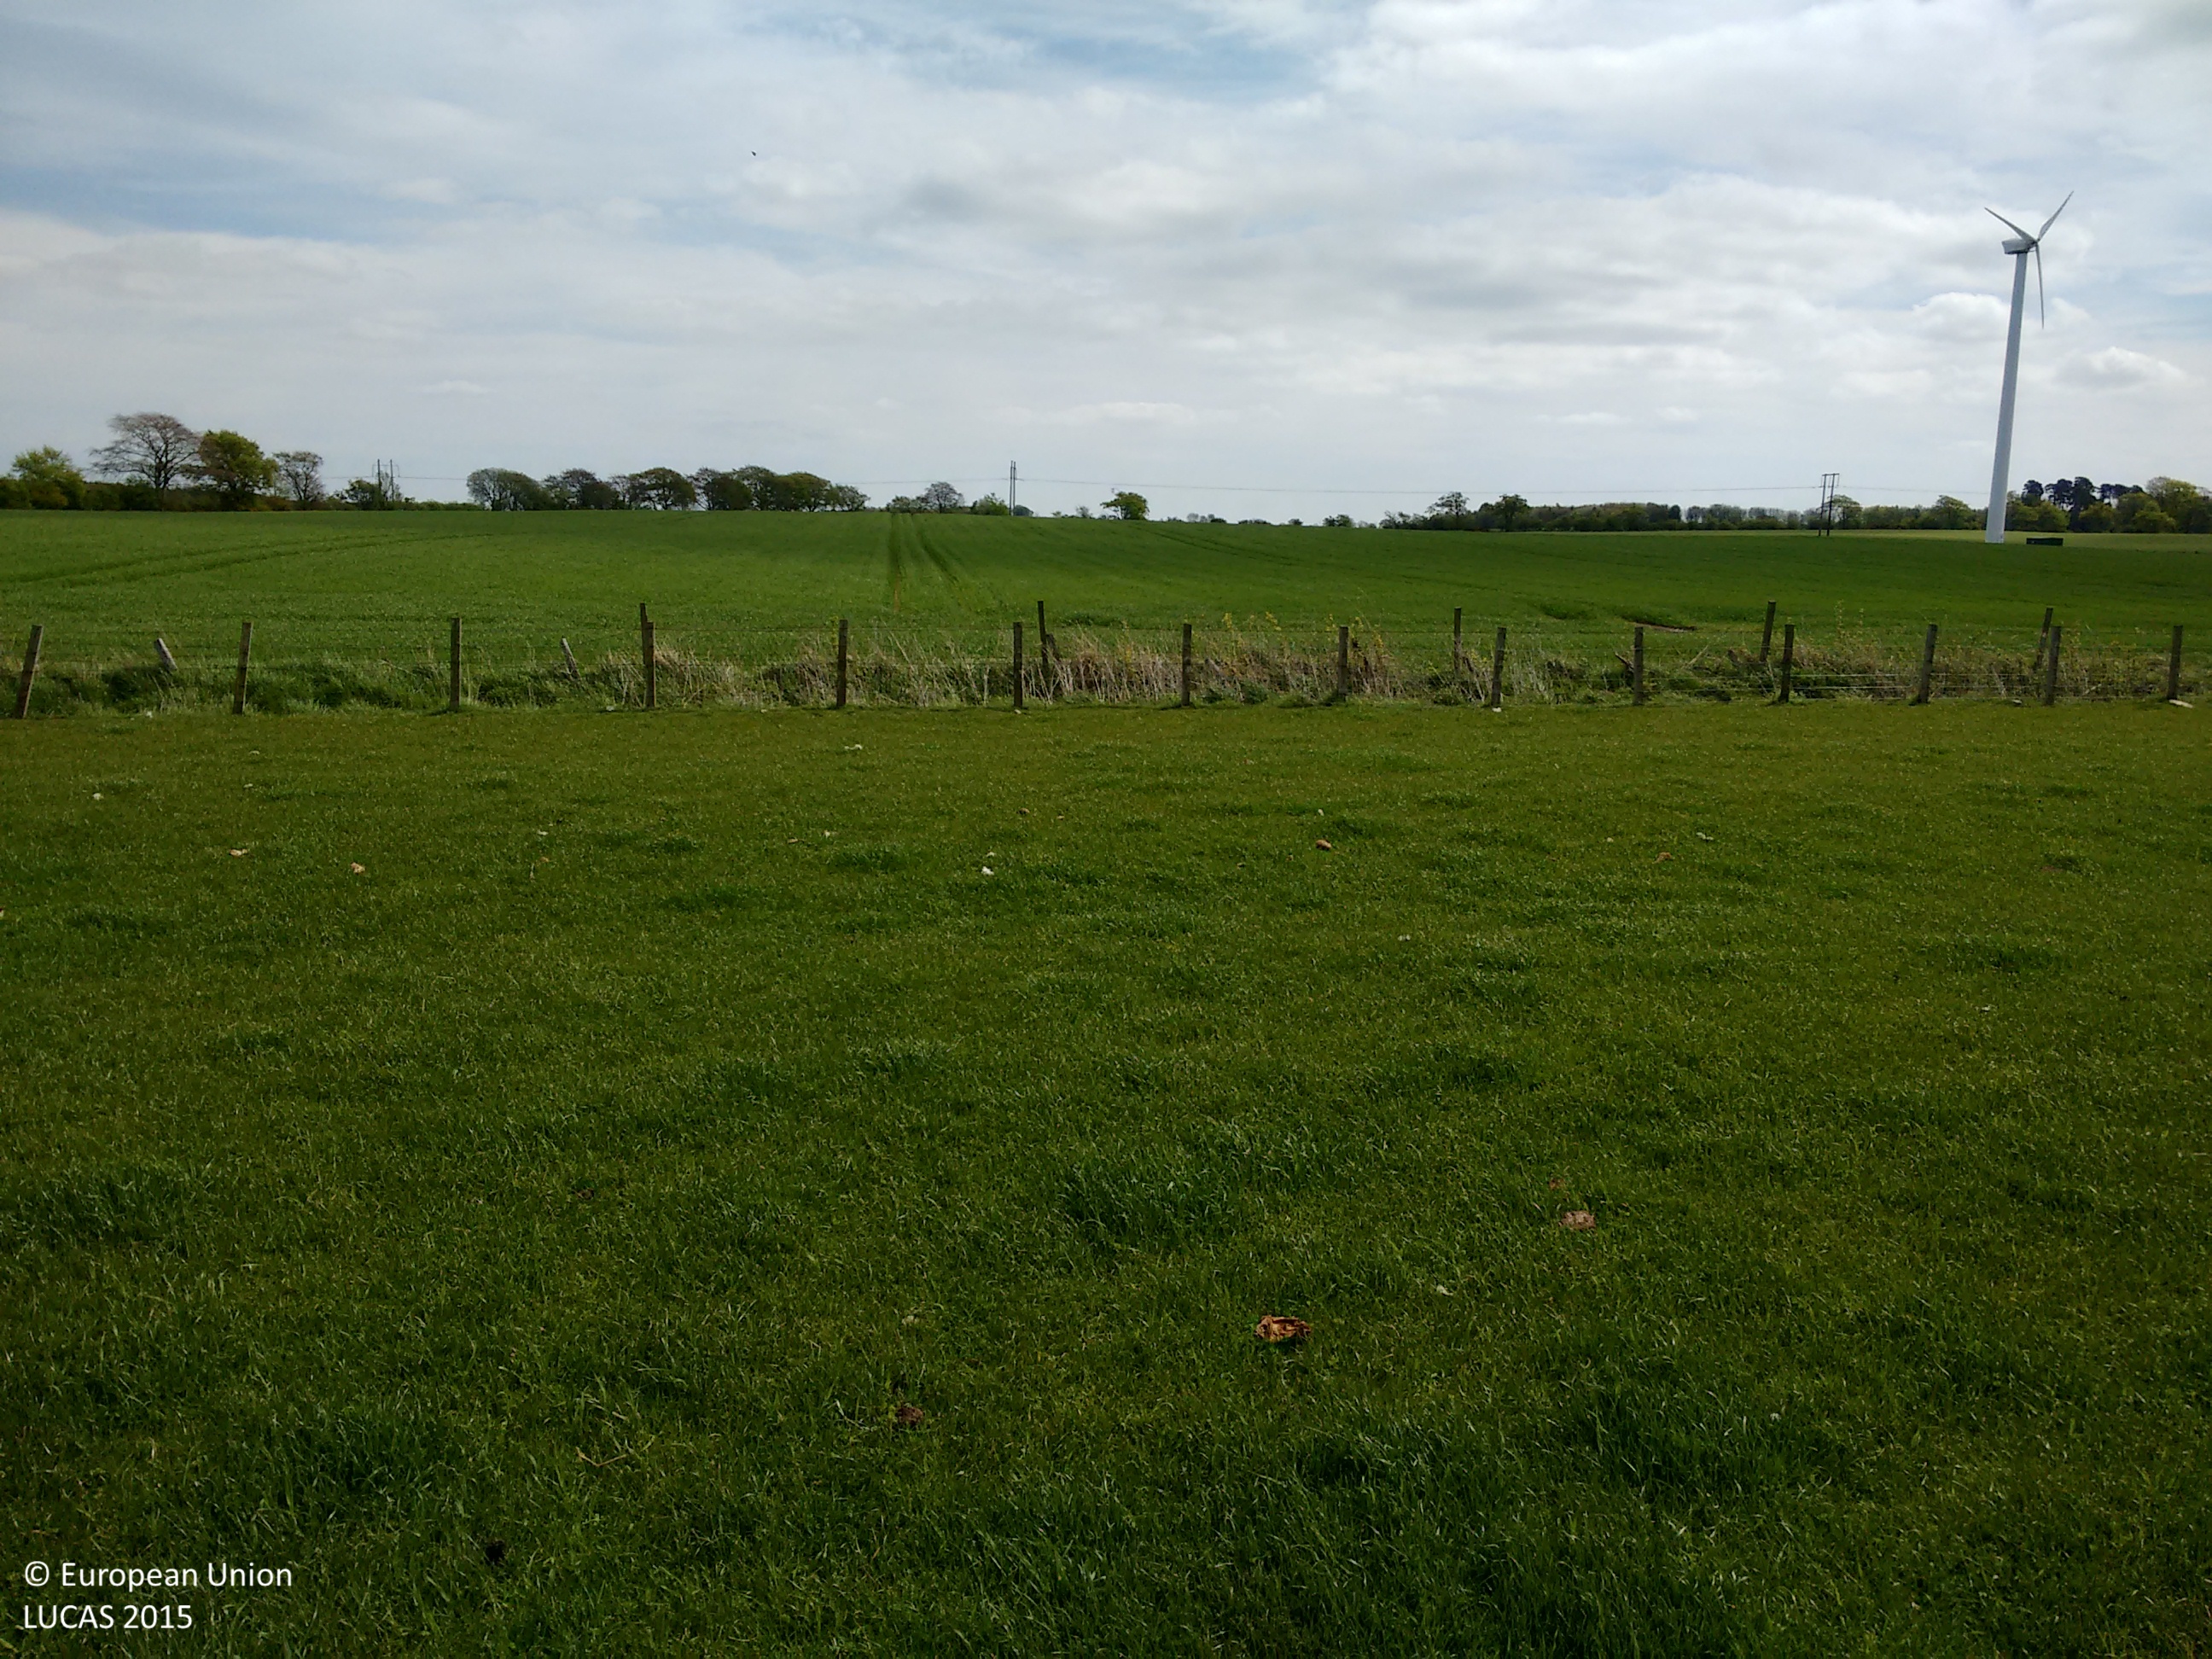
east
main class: Grassland
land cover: Grassland without tree/shrub cover
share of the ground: > 75 %
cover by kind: herbaceous plants 100 %
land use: Agriculture (excluding fallow land and kitchen gardens)
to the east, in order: Grassland without tree/shrub cover; Fences; Grass margins; Ditches and canals; Grass margins; Fences; Grass margins; Barley
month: May
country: GB
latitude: 56.7451
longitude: -2.6323
